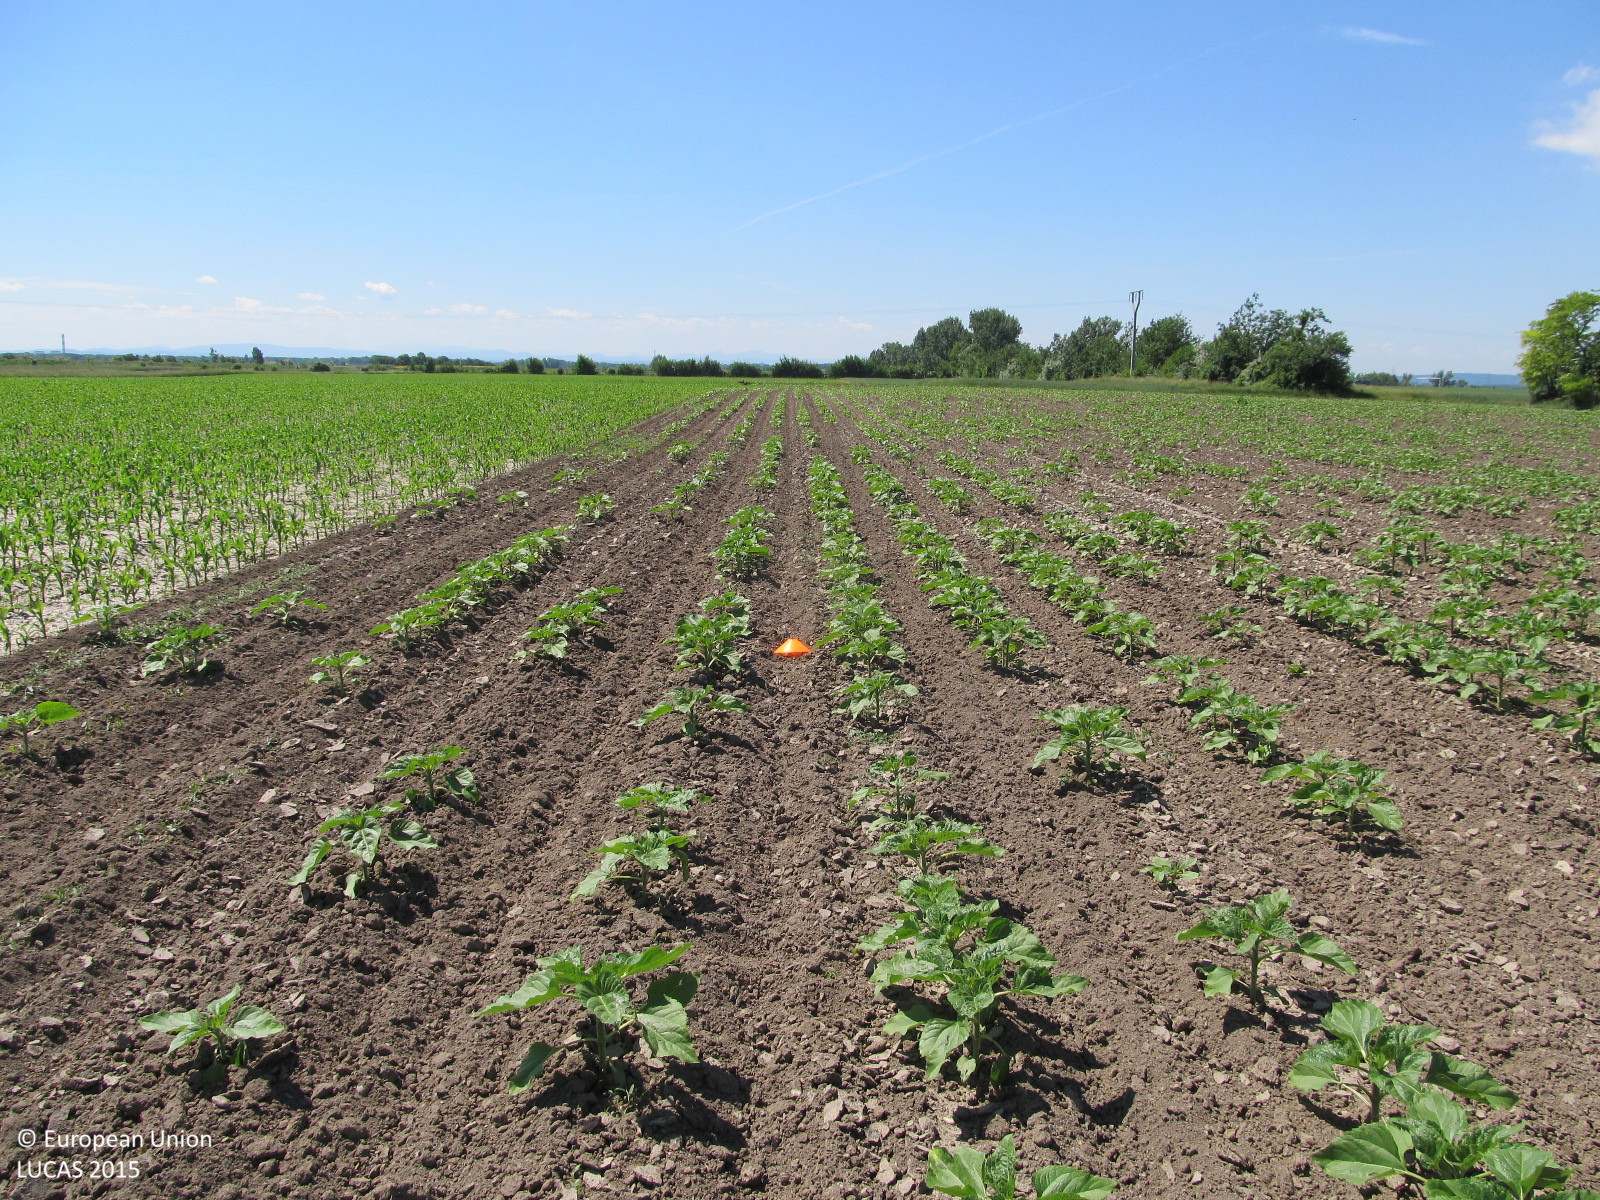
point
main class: Cropland
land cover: Sunflower
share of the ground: < 10 %
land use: Agriculture (excluding fallow land and kitchen gardens)
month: June
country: AT
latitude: 48.4079
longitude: 15.9073
